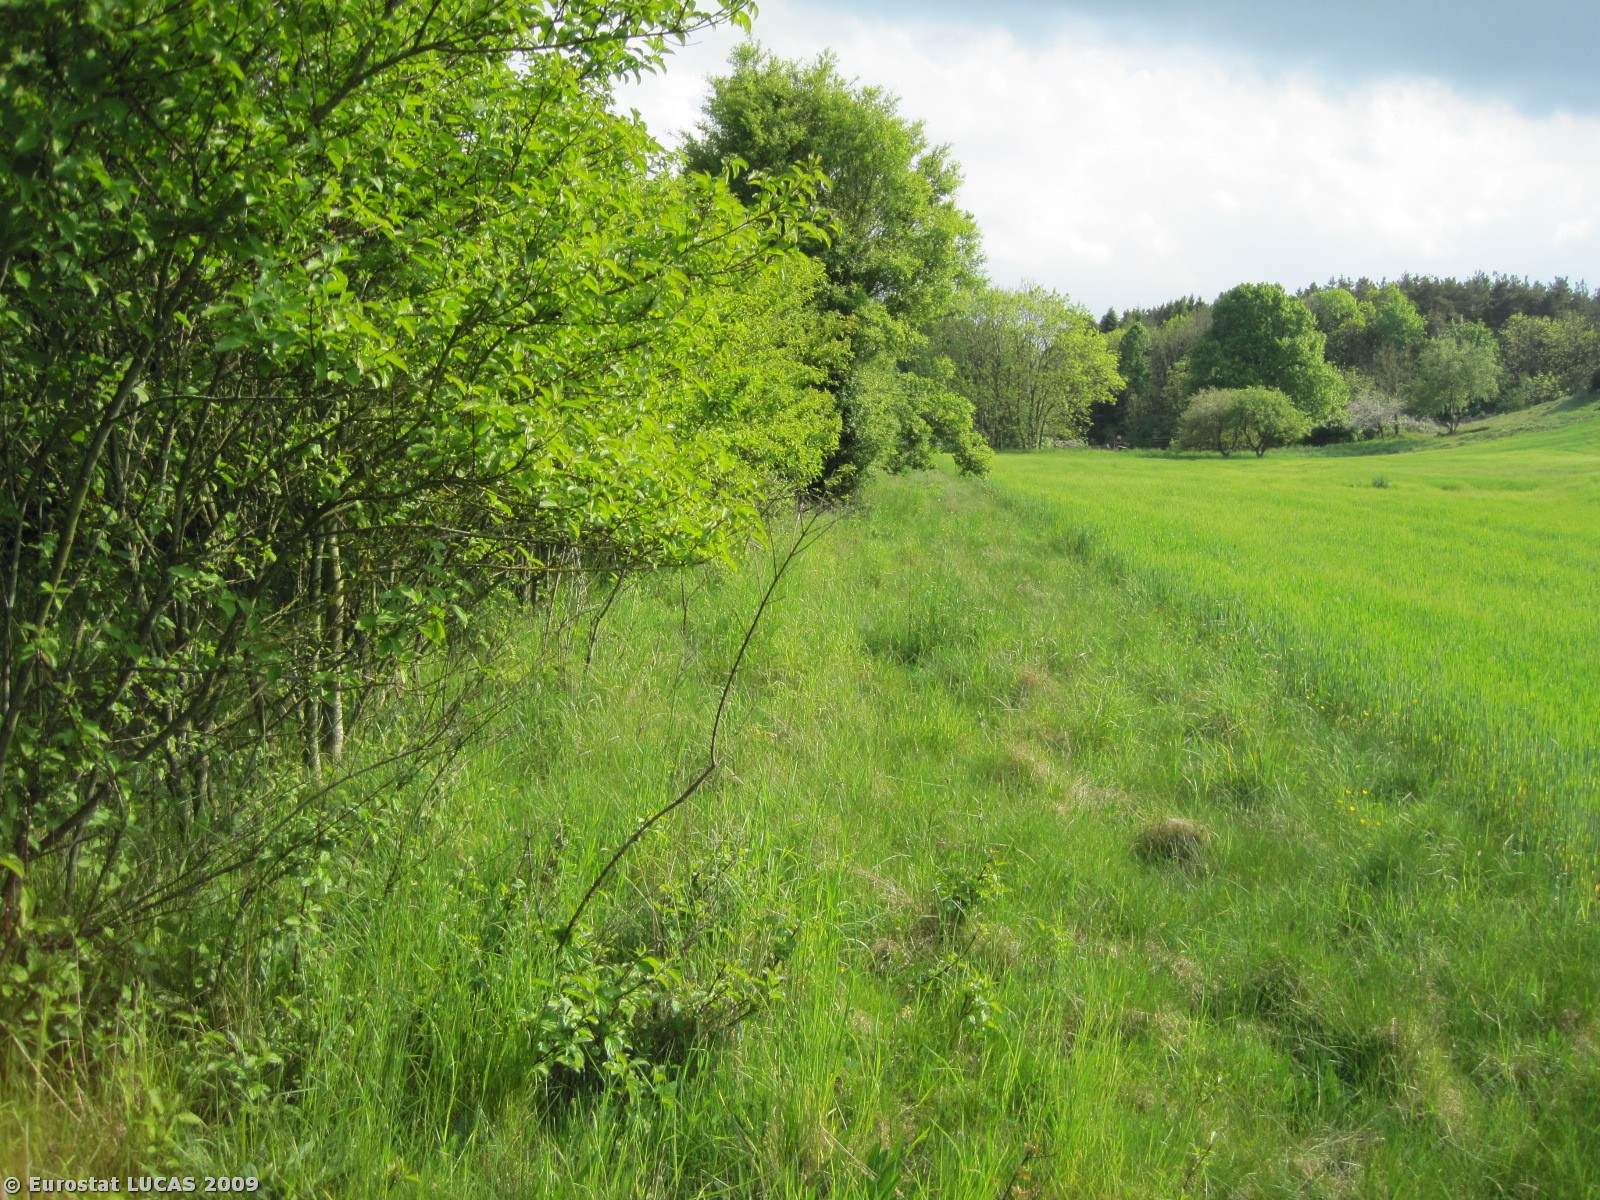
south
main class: Grassland
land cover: Grassland without tree/shrub cover
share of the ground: > 75 %
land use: Unused
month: May
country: DK
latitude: 56.6910
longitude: 10.1467
